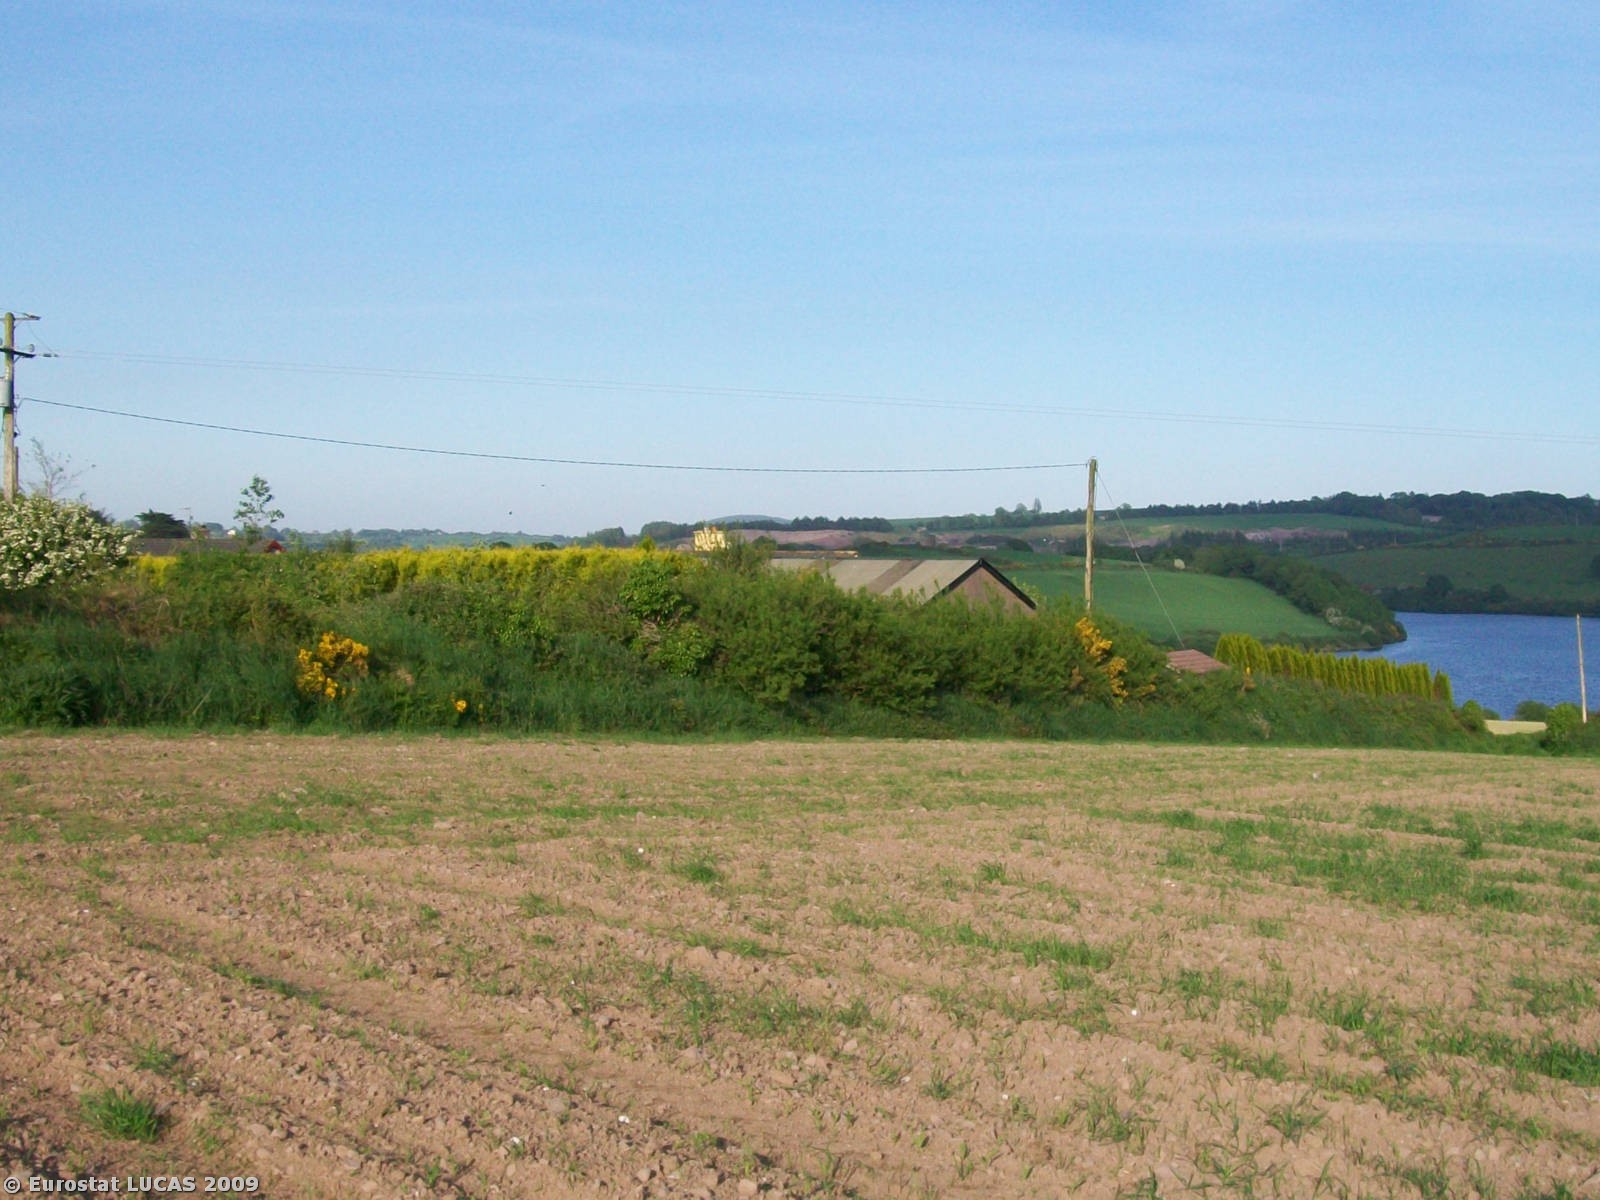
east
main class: Cropland
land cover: Common wheat
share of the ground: > 75 %
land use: Agriculture (excluding fallow land and kitchen gardens)
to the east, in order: Common wheat; Abandoned hedges; Grassland without tree/shrub cover; Managed hedges; Grassland without tree/shrub cover; Artificial constructions in urban areas; Grassland without tree/shrub cover; Managed hedges; Grassland without tree/shrub cover; Artificial constructions in urban areas; Managed hedges; Fences; Grassland without tree/shrub cover
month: May
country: IE
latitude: 51.9012
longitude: -8.7333
